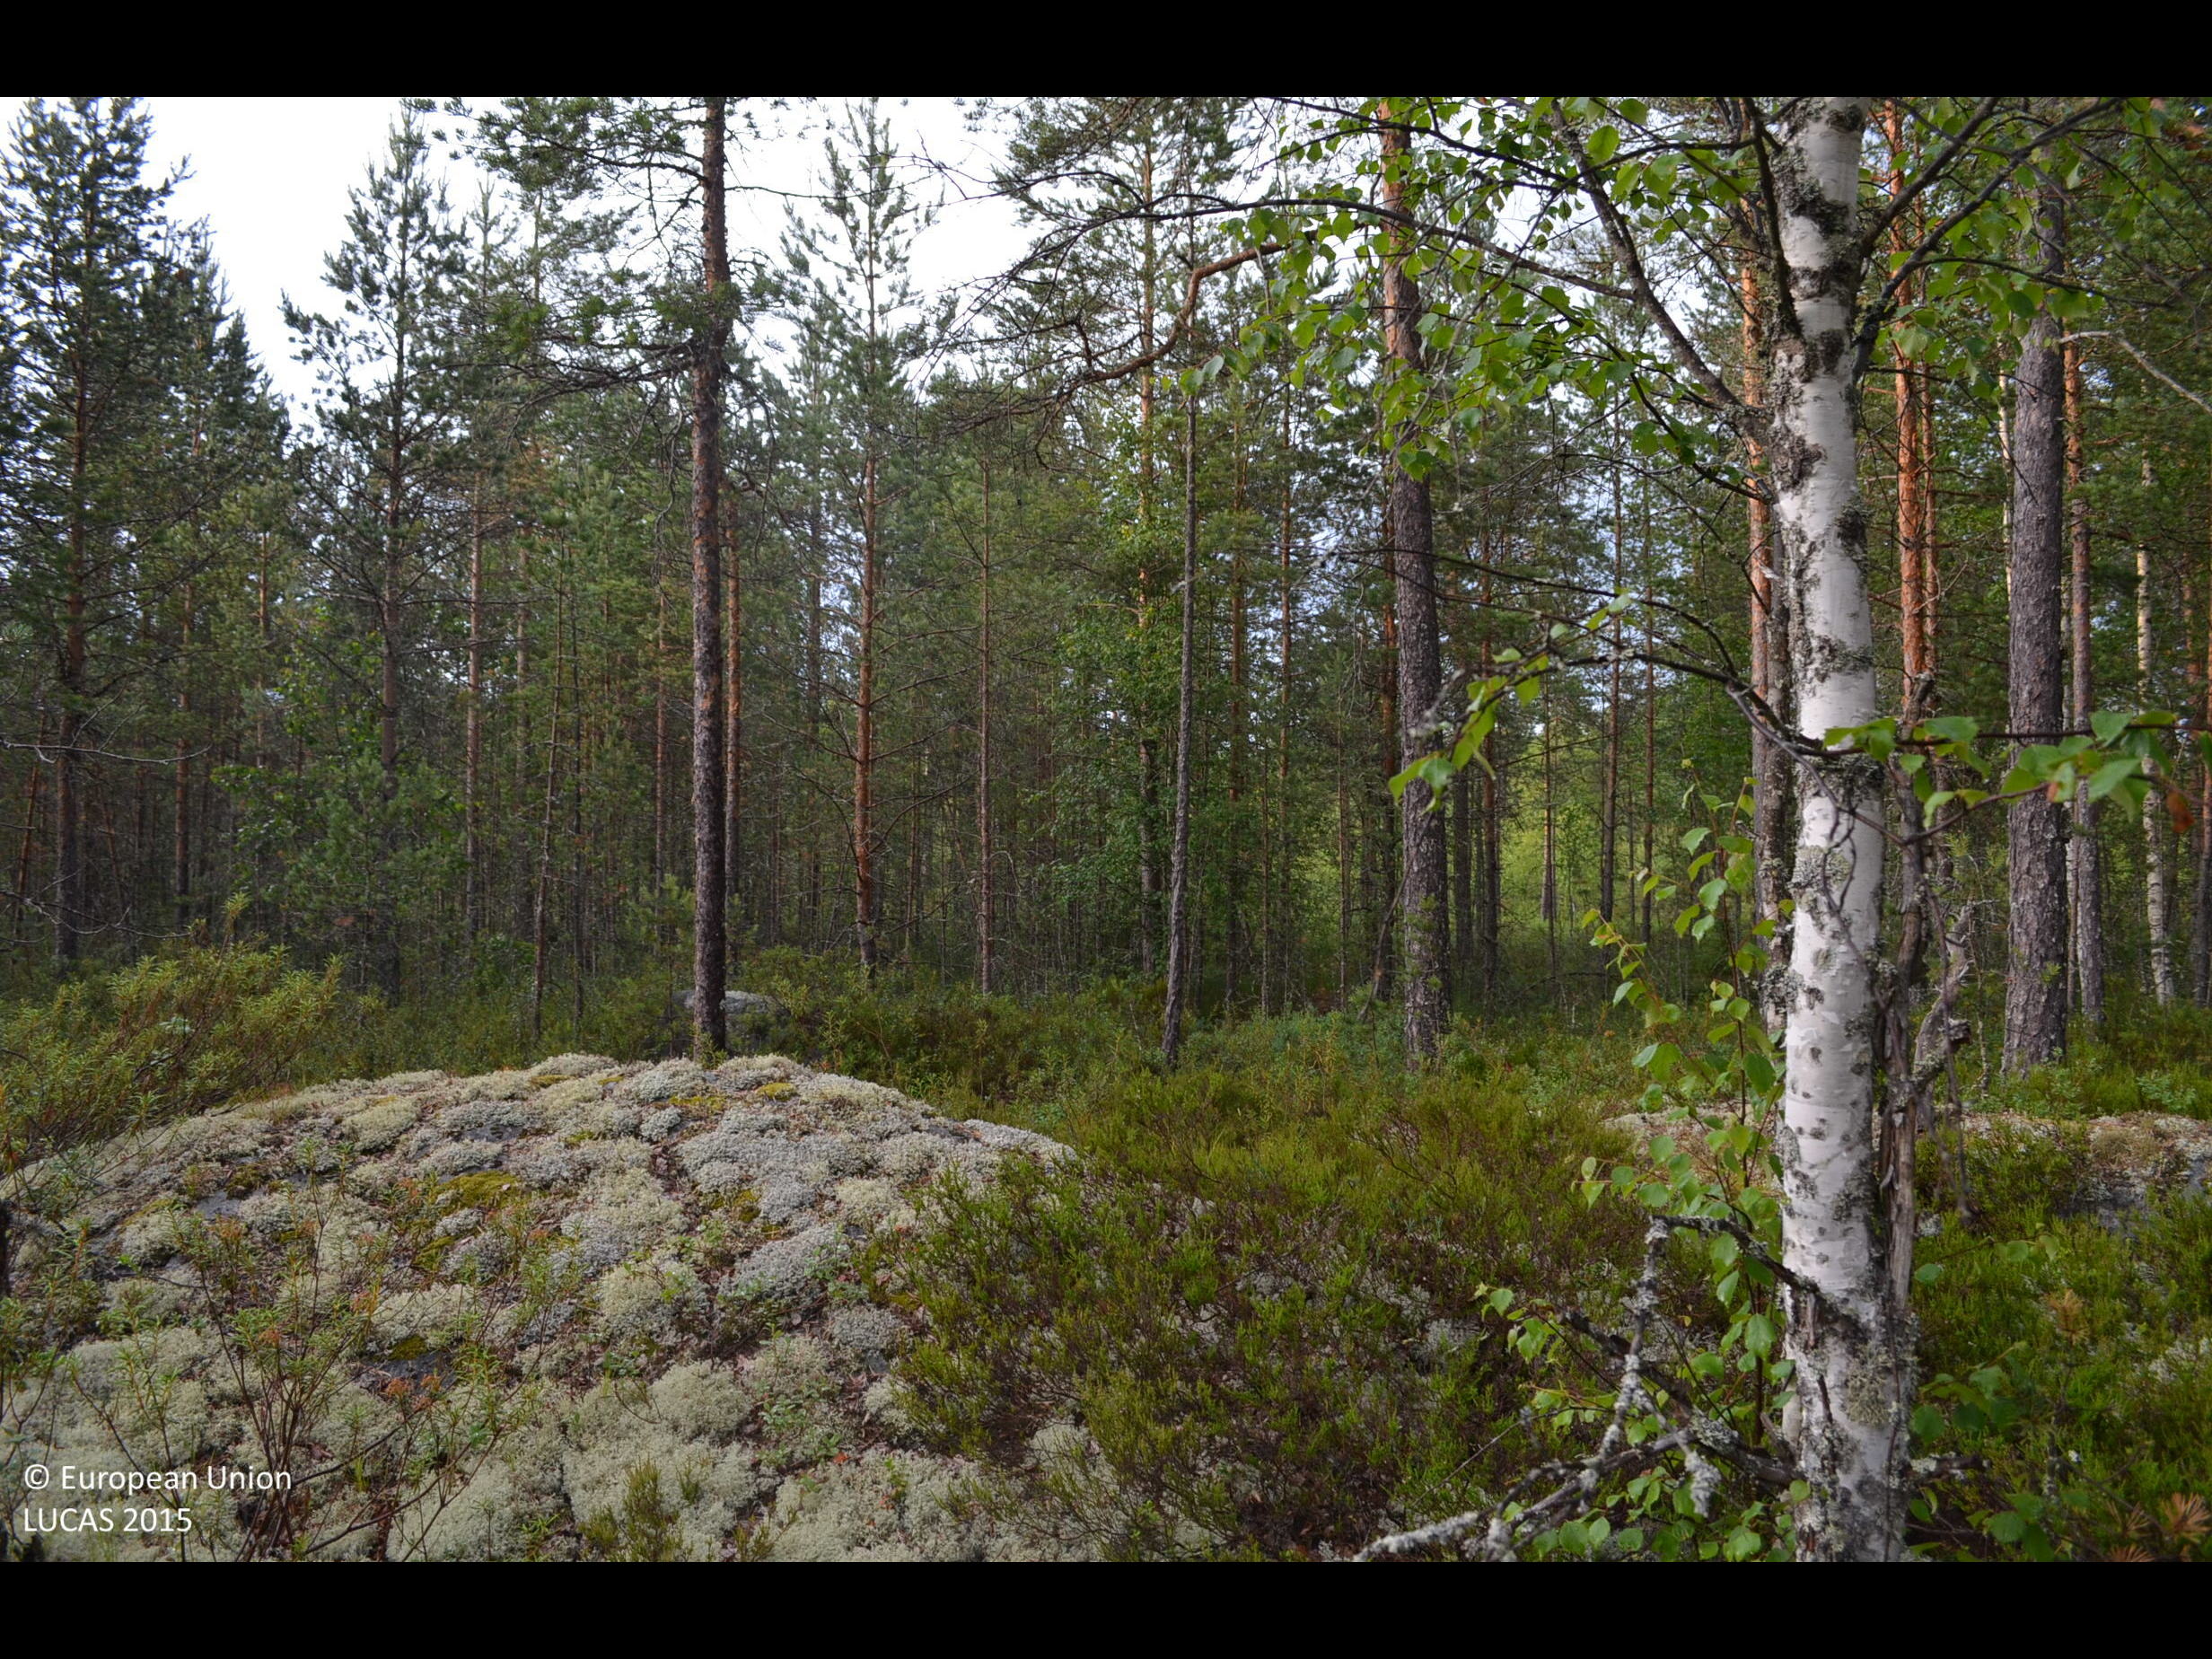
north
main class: Woodland
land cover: Pine dominated coniferous woodland
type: boreal forest
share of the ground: 50 - 75 %
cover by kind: coniferous forest trees 55 %, shrubs 35 %, broadleaved forest trees 5 %, unconsolidated bare surface 5 %
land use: Forestry
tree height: > 5 m
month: July
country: FI
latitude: 62.2296
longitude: 23.4042
